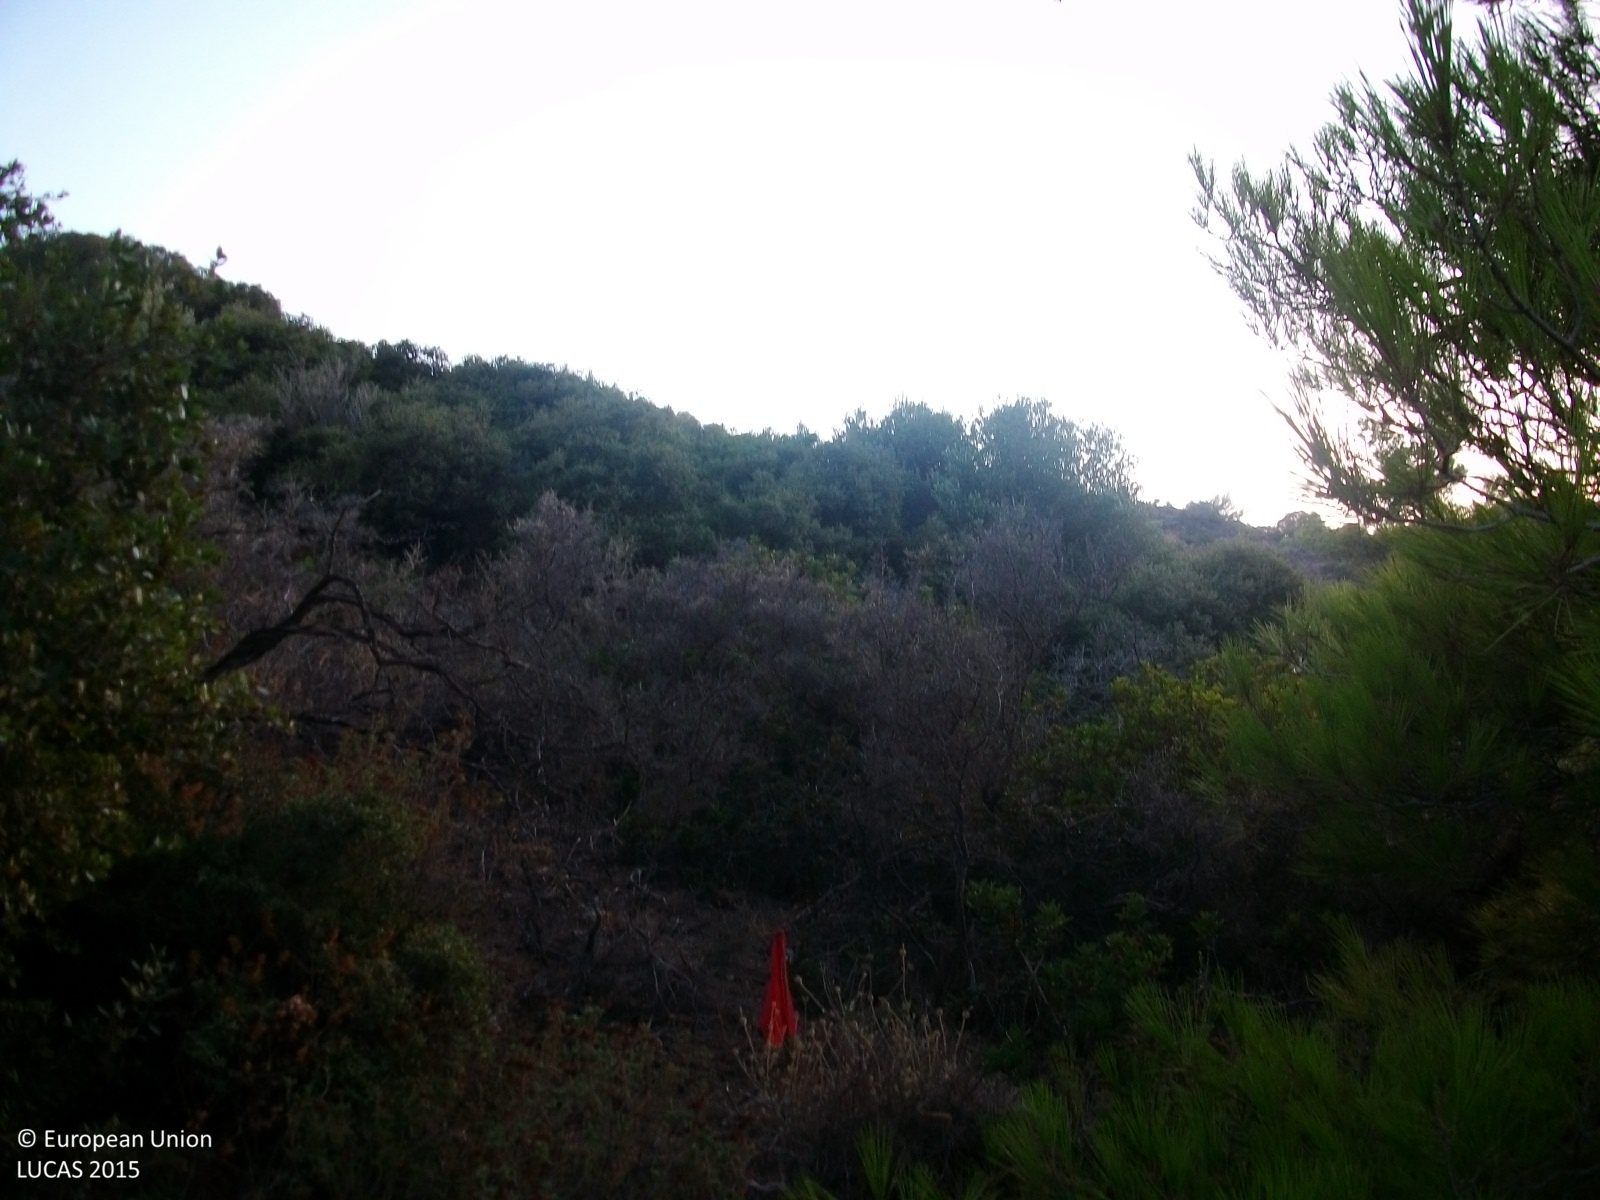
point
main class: Woodland
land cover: Pine dominated coniferous woodland
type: coniferous forest of the mediterranean region
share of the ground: 10 - 25 %
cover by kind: shrubs 70 %, coniferous forest trees 20 %, herbaceous plants 10 %
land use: Semi-natural and natural areas not in use
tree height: < 5 m
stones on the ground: 10 - 25 %
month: August
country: GR
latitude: 35.1139
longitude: 25.7629
